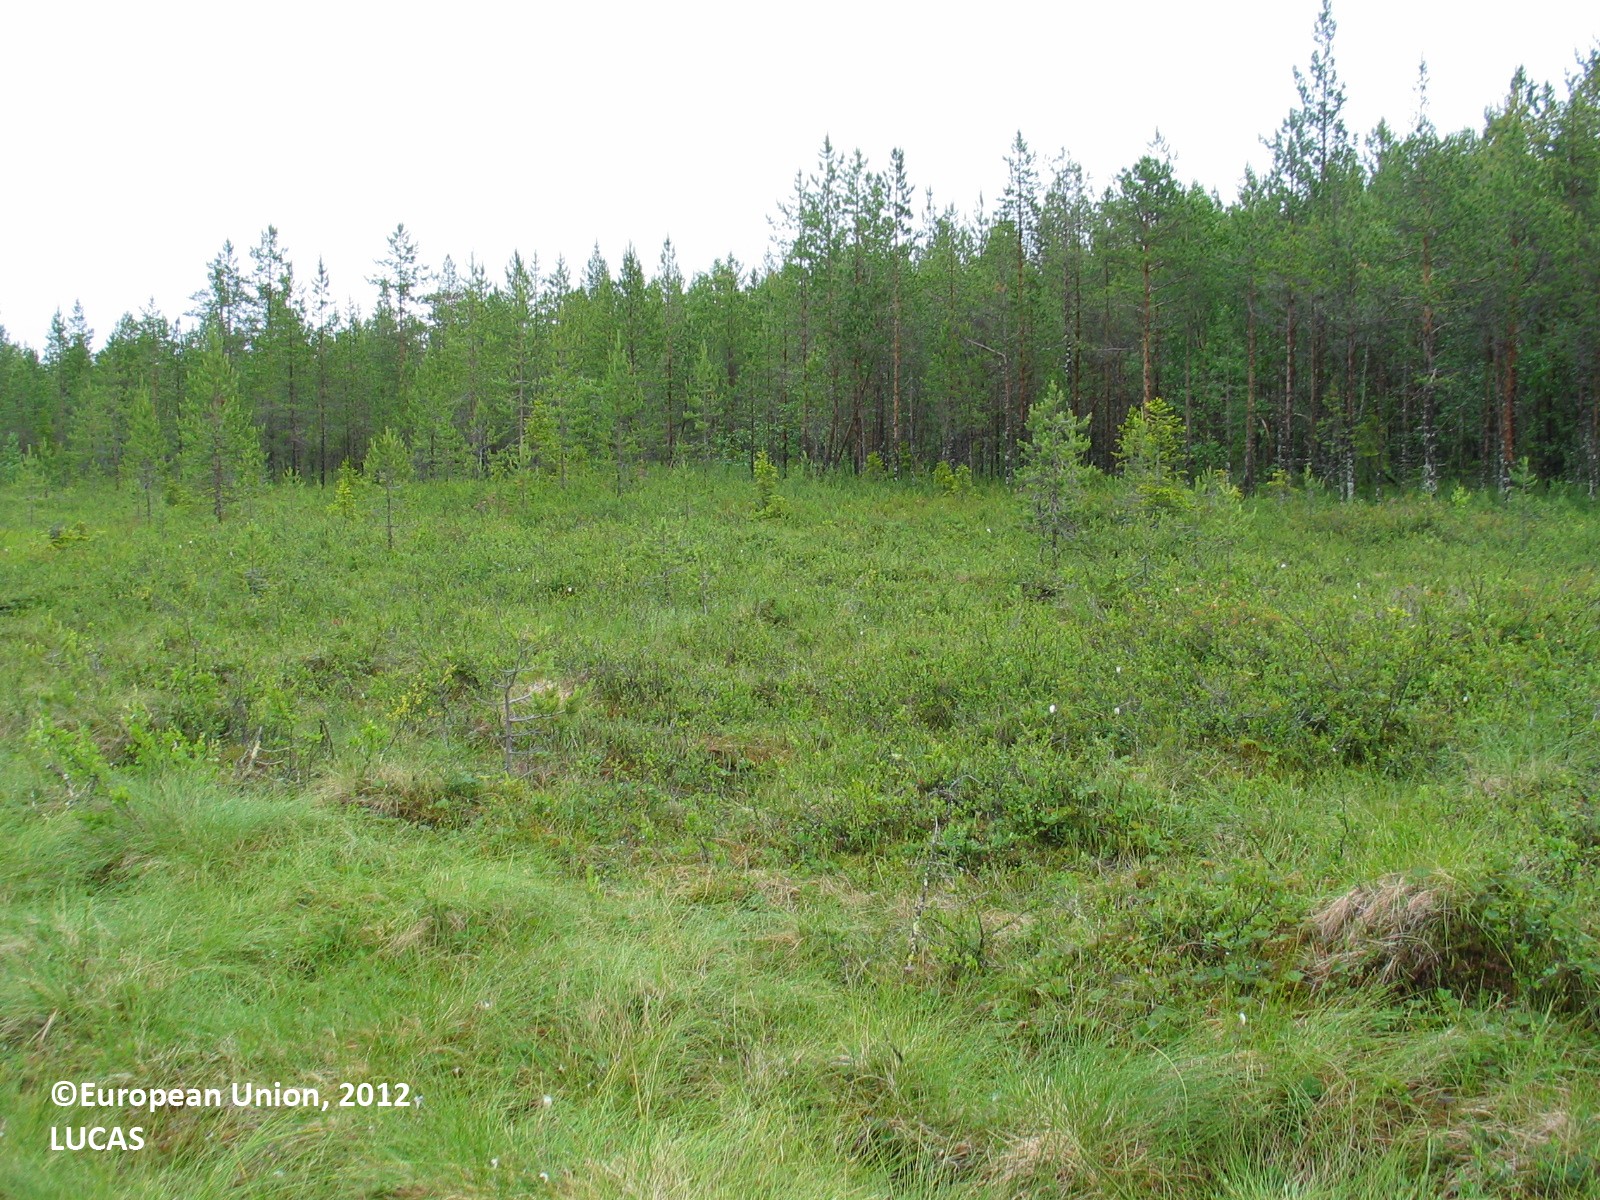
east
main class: Grassland
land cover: Grassland without tree/shrub cover
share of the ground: > 75 %
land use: Energy production
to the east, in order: Grassland without tree/shrub cover; Shrubland with sparse tree cover; Pine dominated coniferous woodland; Ditches and canals; Pine dominated mixed woodland; Pine dominated coniferous woodland; Ditches and canals; Pine dominated coniferous woodland; Ditches and canals; Pine dominated coniferous woodland
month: July
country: FI
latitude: 66.0444
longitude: 25.0025
